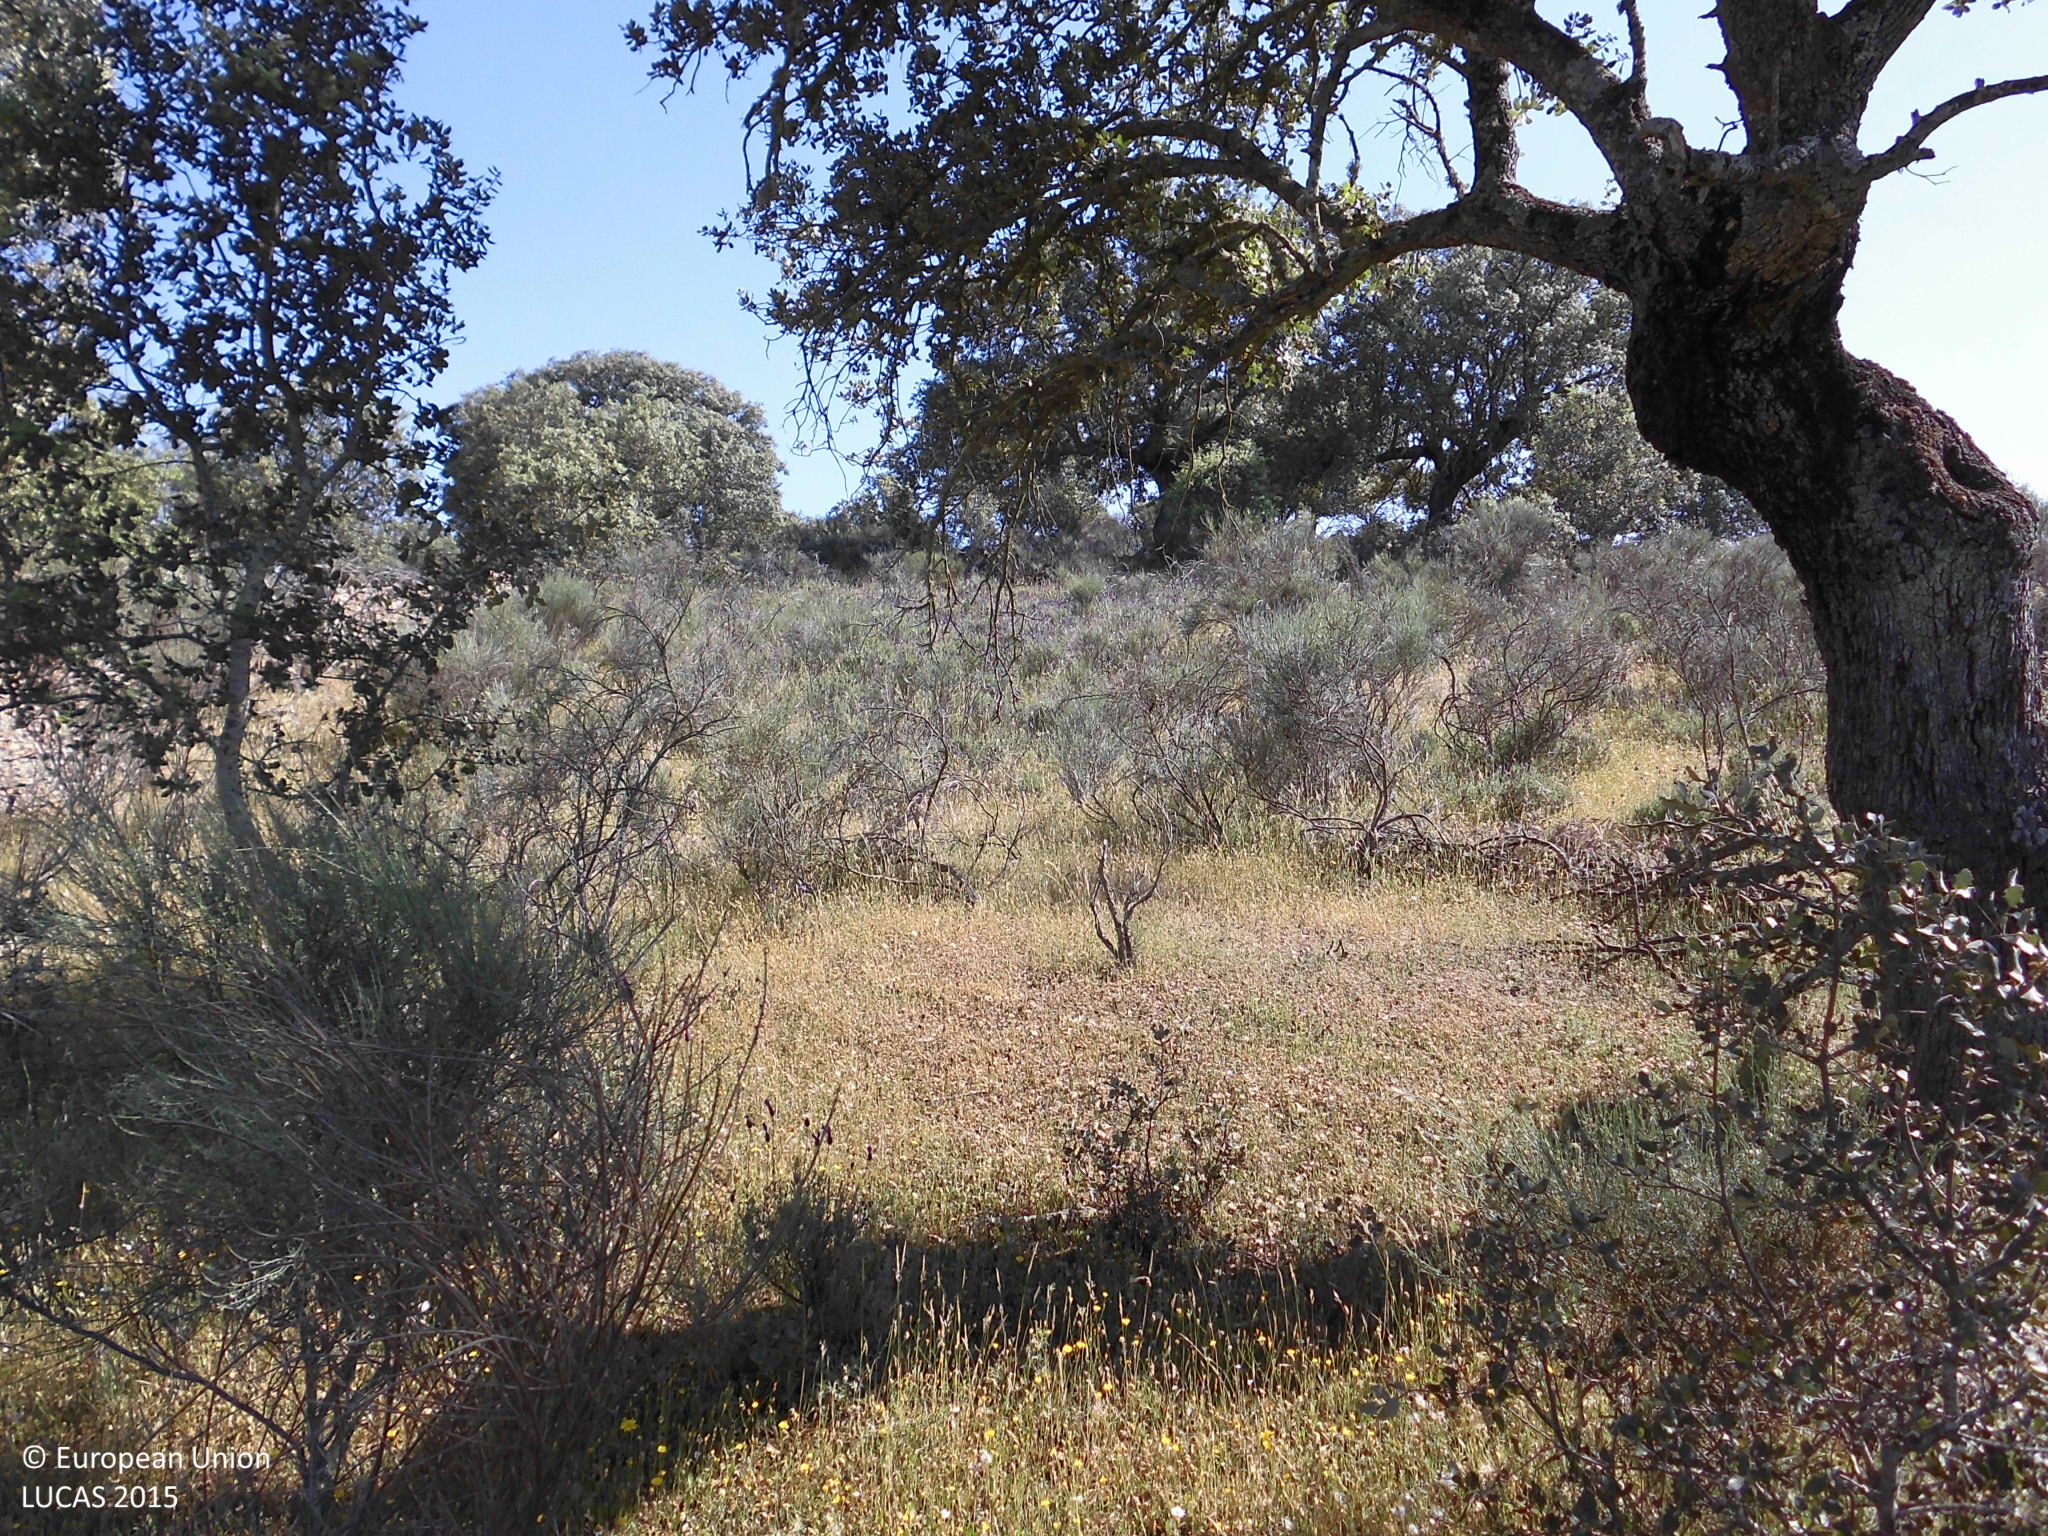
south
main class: Woodland
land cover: Broadleaved woodland
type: broadleaved evergreen forest
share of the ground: 25 - 50 %
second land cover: Shrubland without tree cover
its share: > 75 %
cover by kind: herbaceous plants 50 %, broadleaved forest trees 30 %, shrubs 20 %
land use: Forestry
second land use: Agriculture (excluding fallow land and kitchen gardens)
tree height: > 5 m
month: May
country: ES
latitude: 39.5339
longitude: -6.1078
